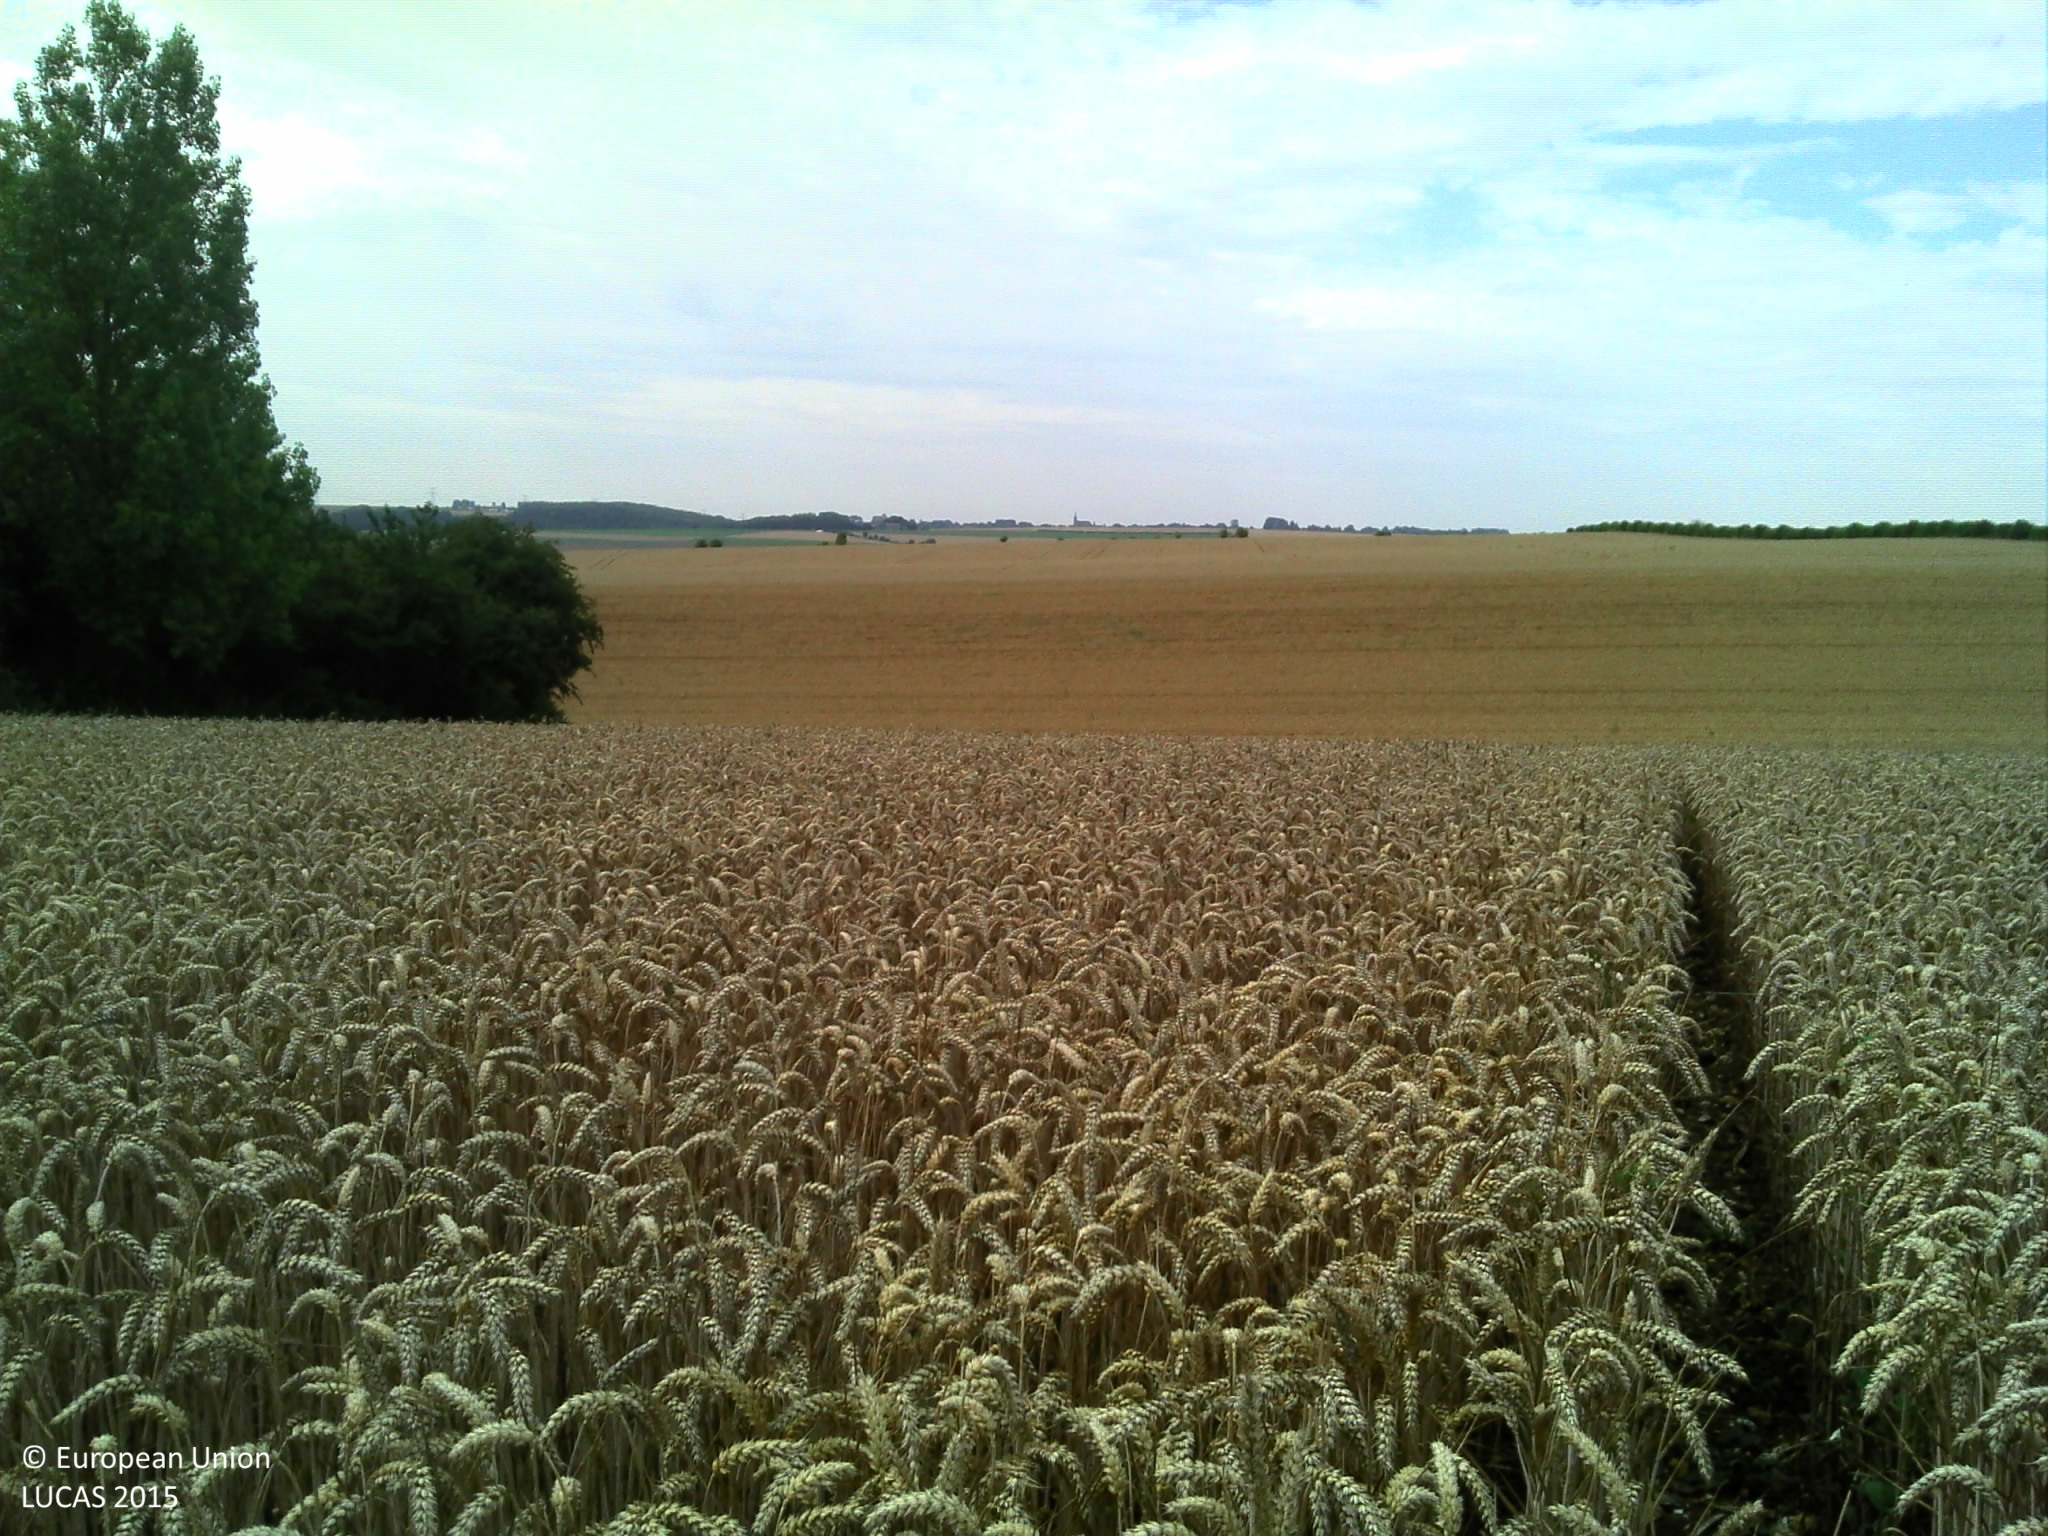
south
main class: Cropland
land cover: Common wheat
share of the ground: > 75 %
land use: Agriculture (excluding fallow land and kitchen gardens)
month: July
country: FR
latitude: 50.0617
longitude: 2.2050
